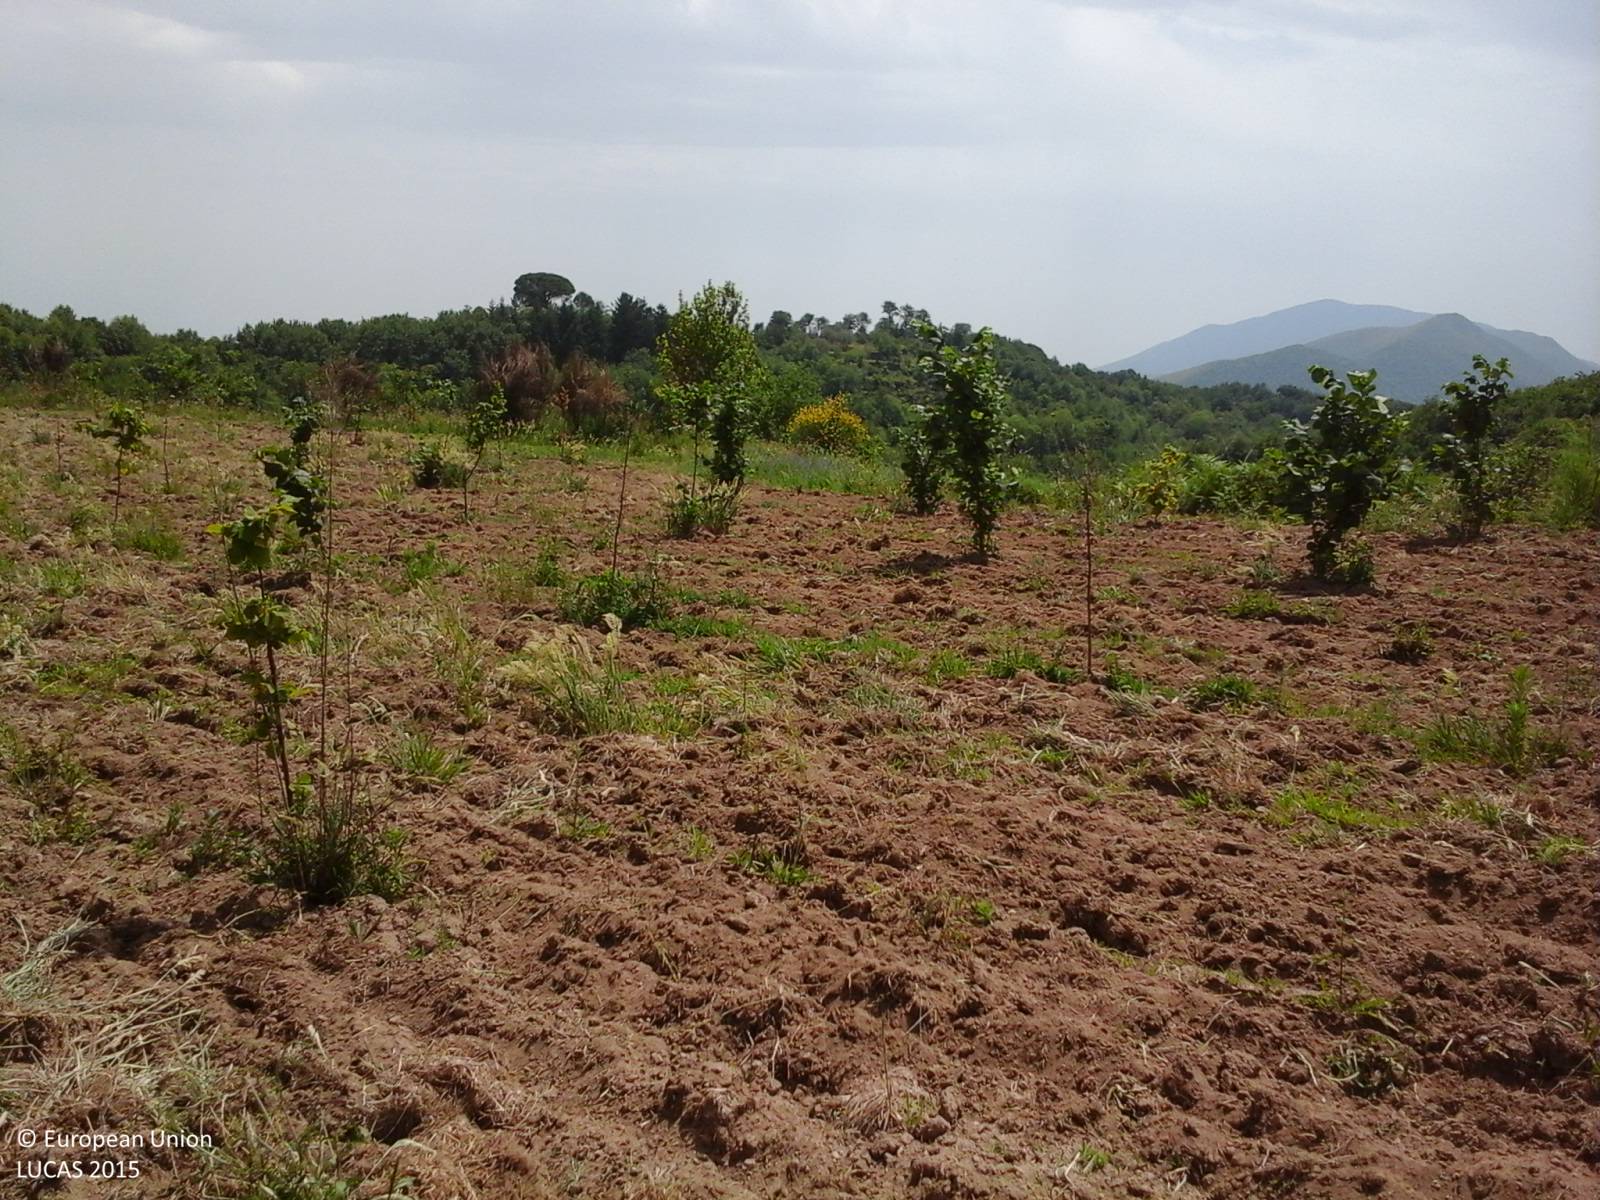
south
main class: Shrubland
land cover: Shrubland without tree cover
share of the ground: > 75 %
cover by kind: shrubs 50 %, herbaceous plants 50 %
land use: Semi-natural and natural areas not in use
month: June
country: IT
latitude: 41.2551
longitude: 13.9825
